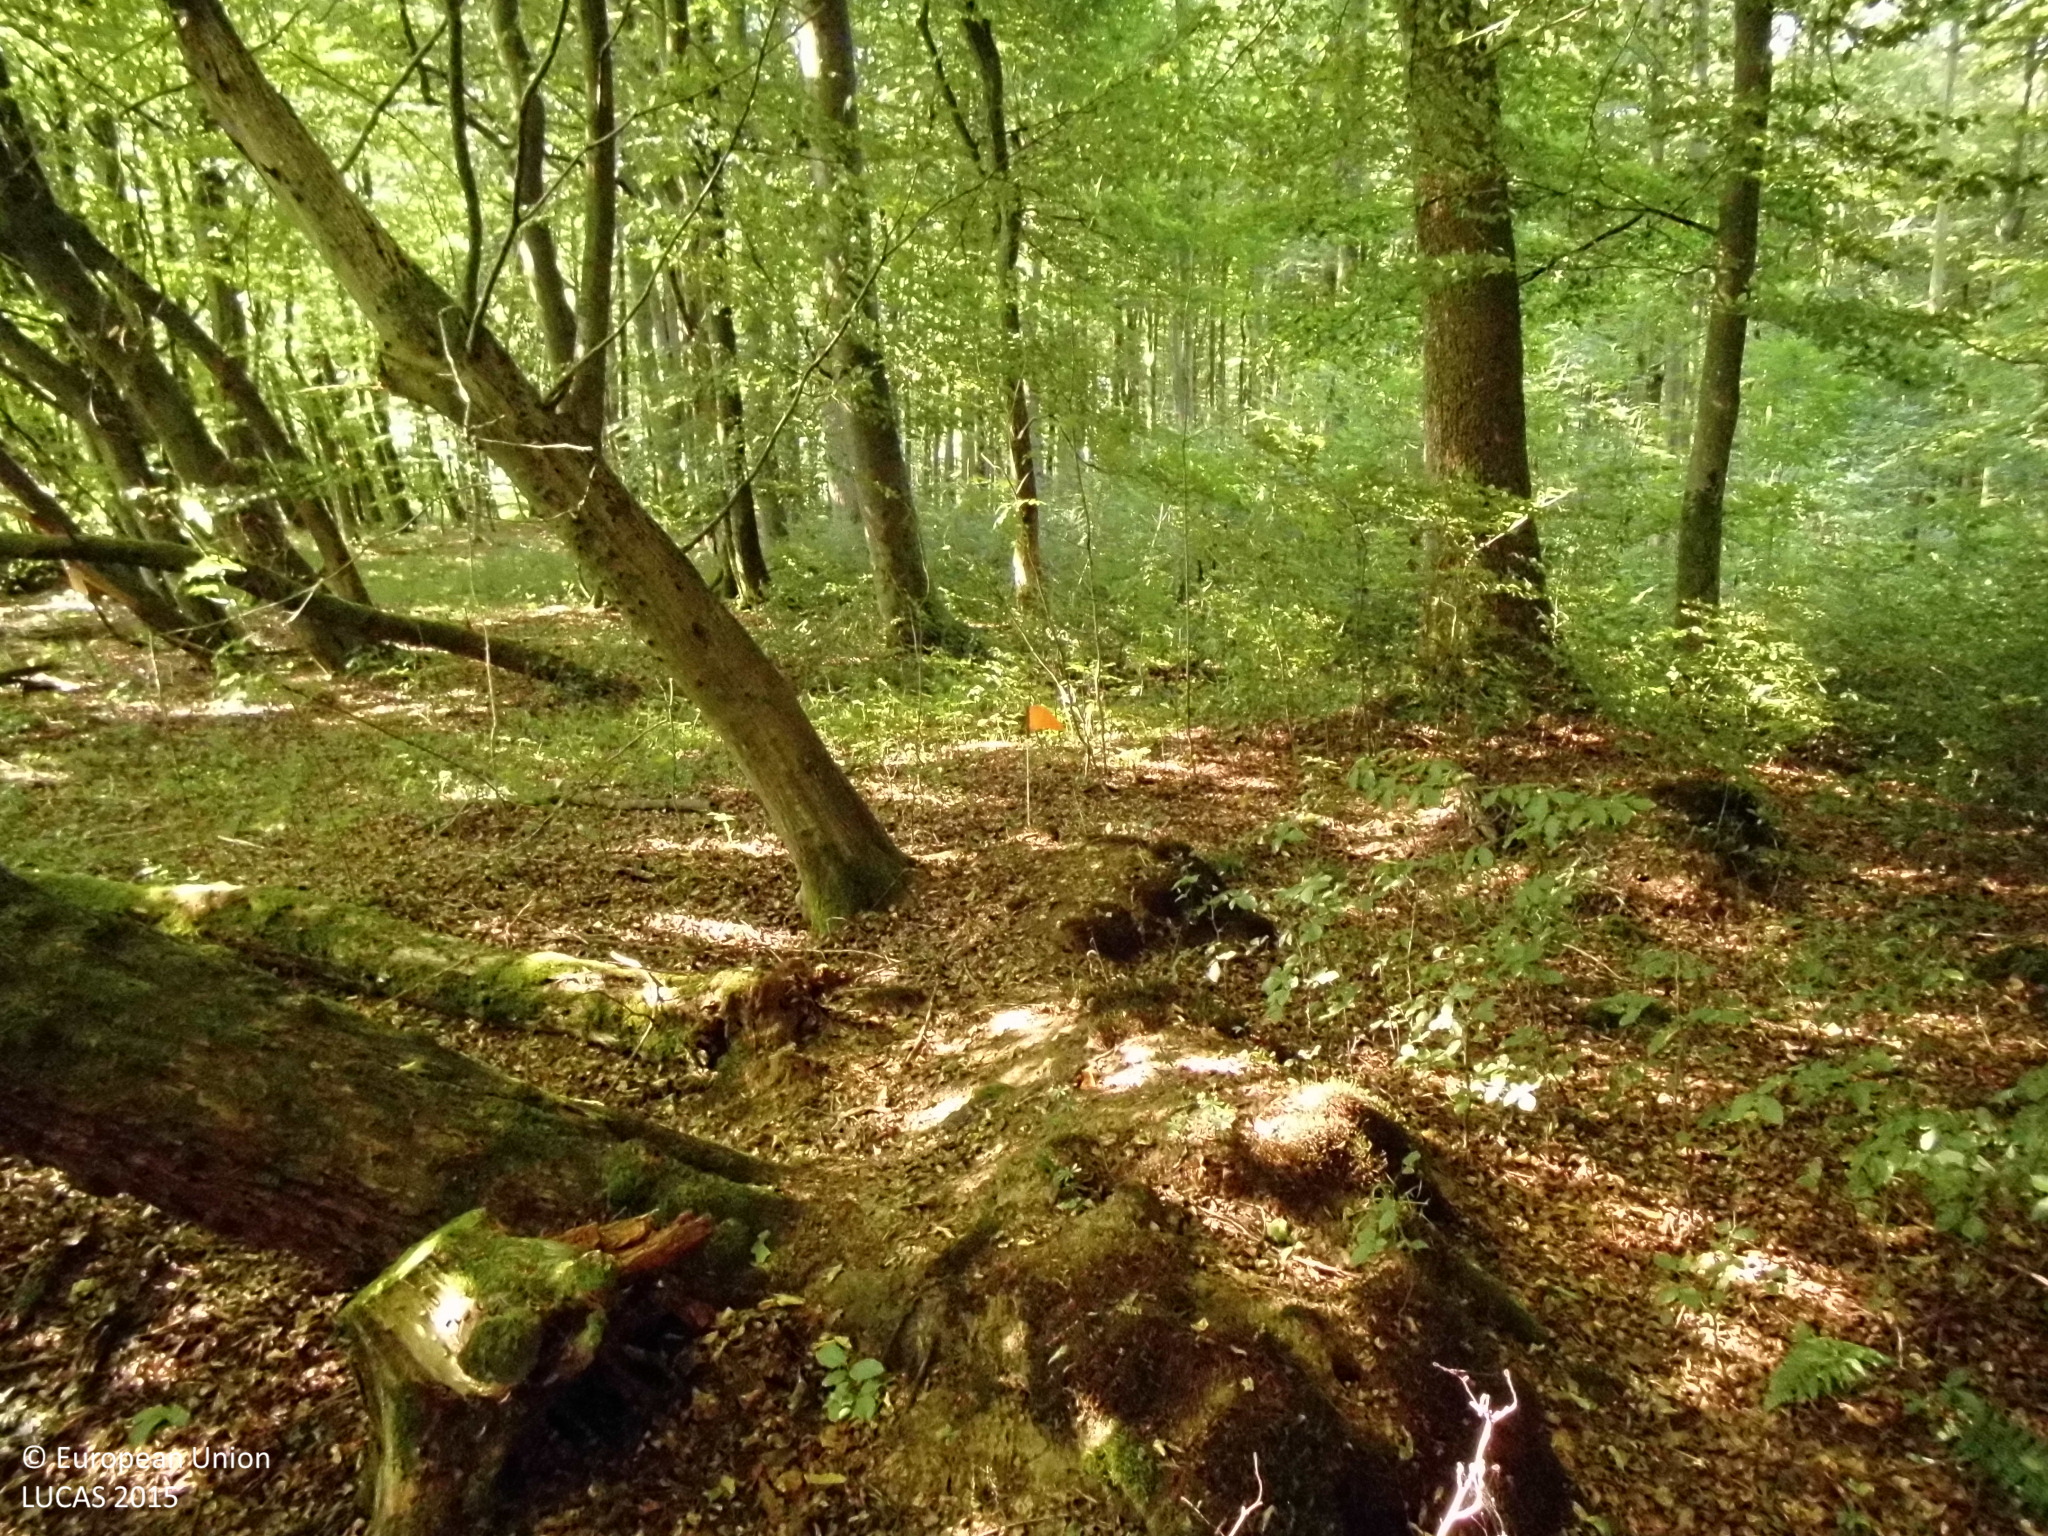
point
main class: Woodland
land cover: Broadleaved woodland
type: mesophytic deciduous forest
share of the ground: > 75 %
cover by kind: broadleaved forest trees 100 %
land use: Forestry
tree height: > 5 m
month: August
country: DE
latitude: 50.5985
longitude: 8.0083
